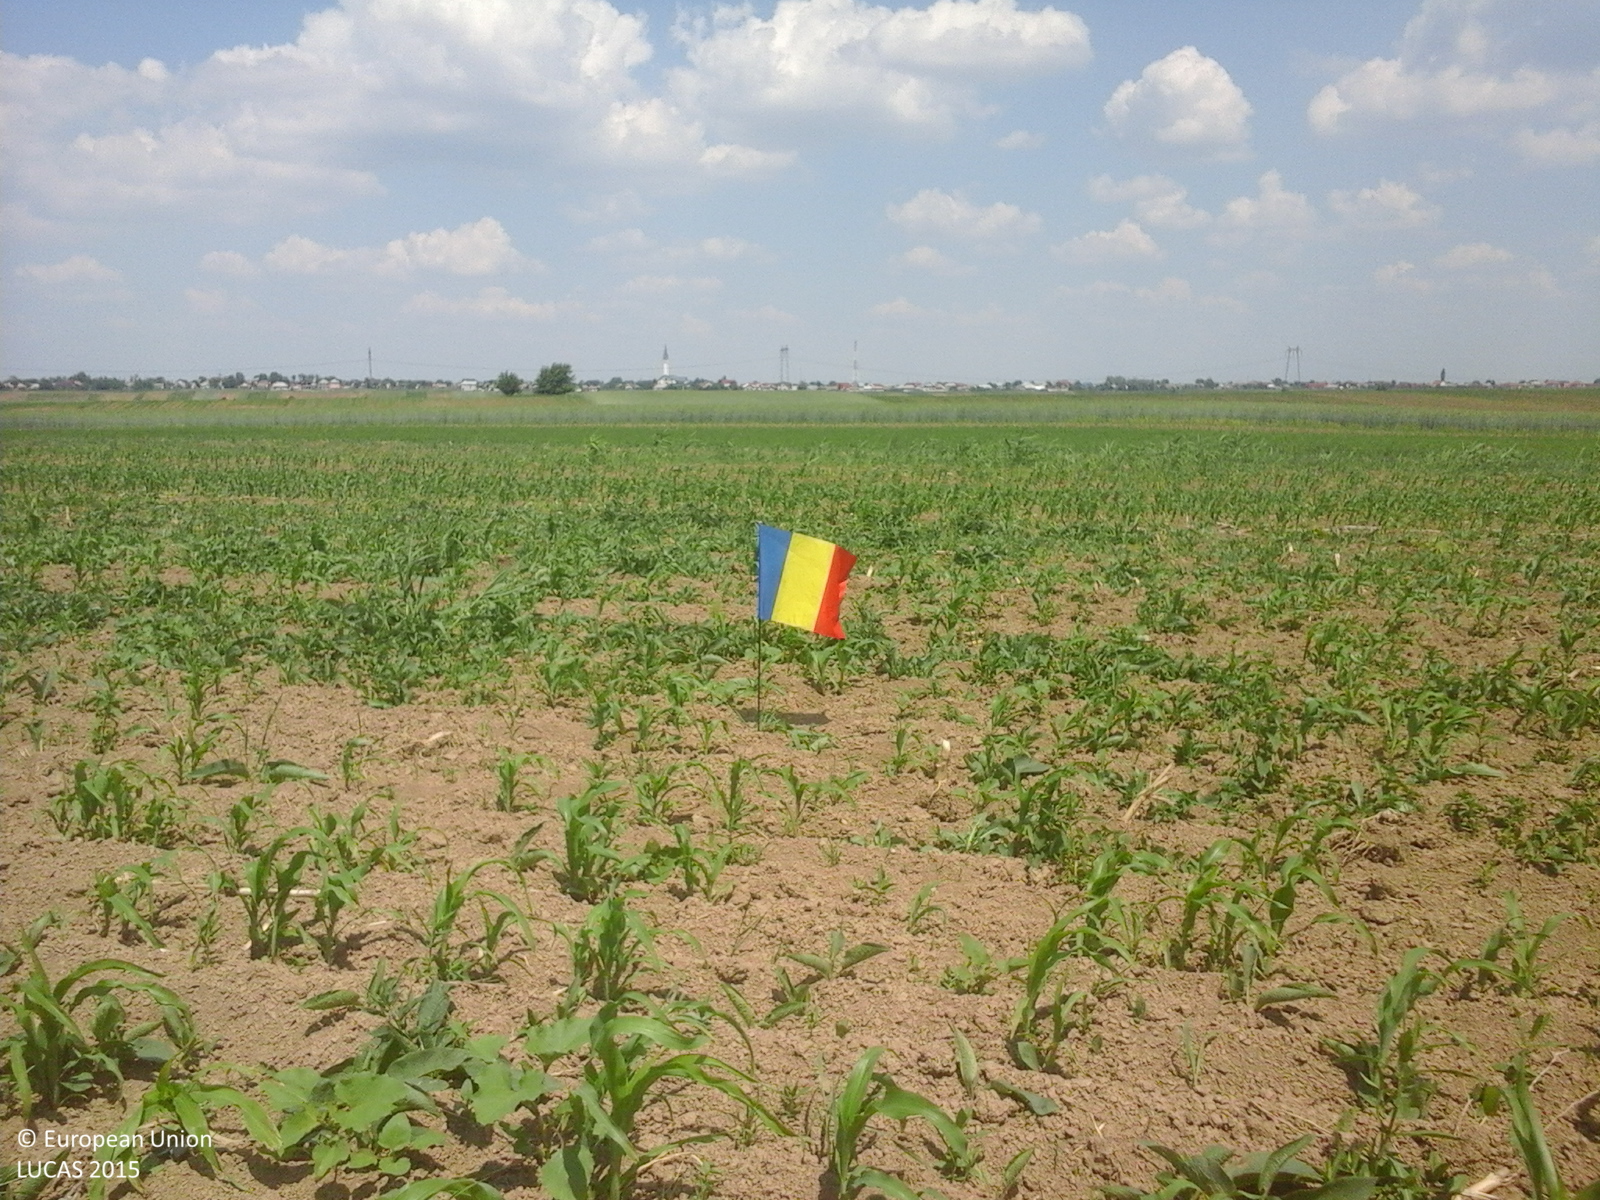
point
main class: Cropland
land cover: Maize
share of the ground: 50 - 75 %
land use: Agriculture (excluding fallow land and kitchen gardens)
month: June
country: RO
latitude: 47.0628
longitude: 26.7215
